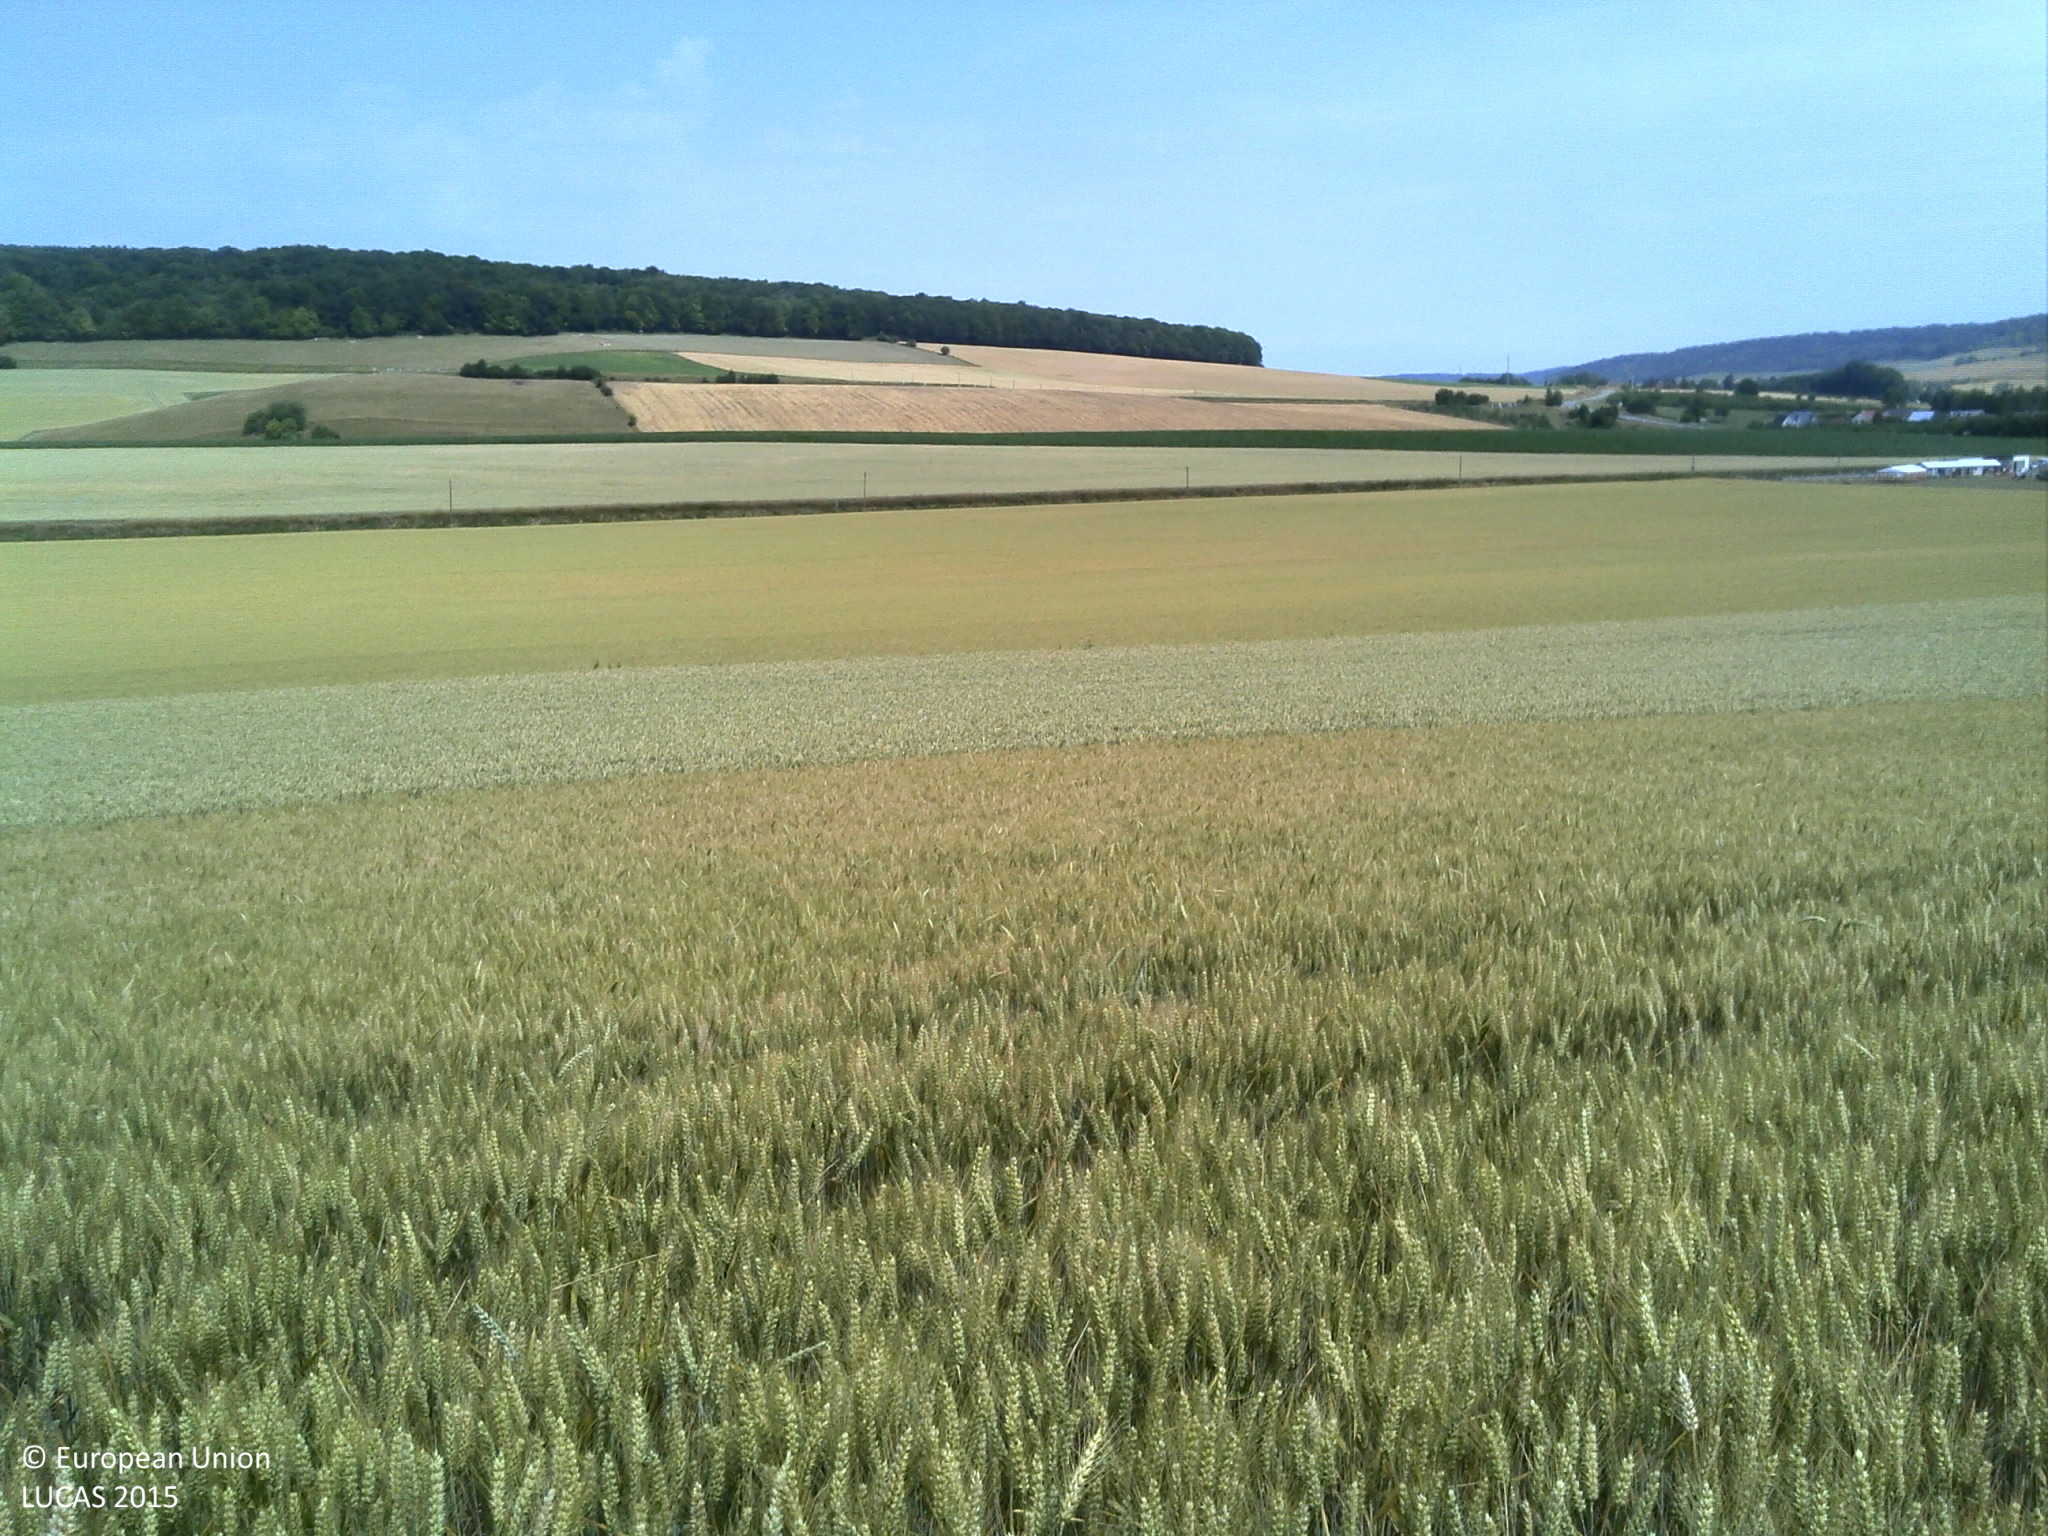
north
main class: Cropland
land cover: Durum wheat
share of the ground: > 75 %
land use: Agriculture (excluding fallow land and kitchen gardens)
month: July
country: FR
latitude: 49.8279
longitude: 1.7114
